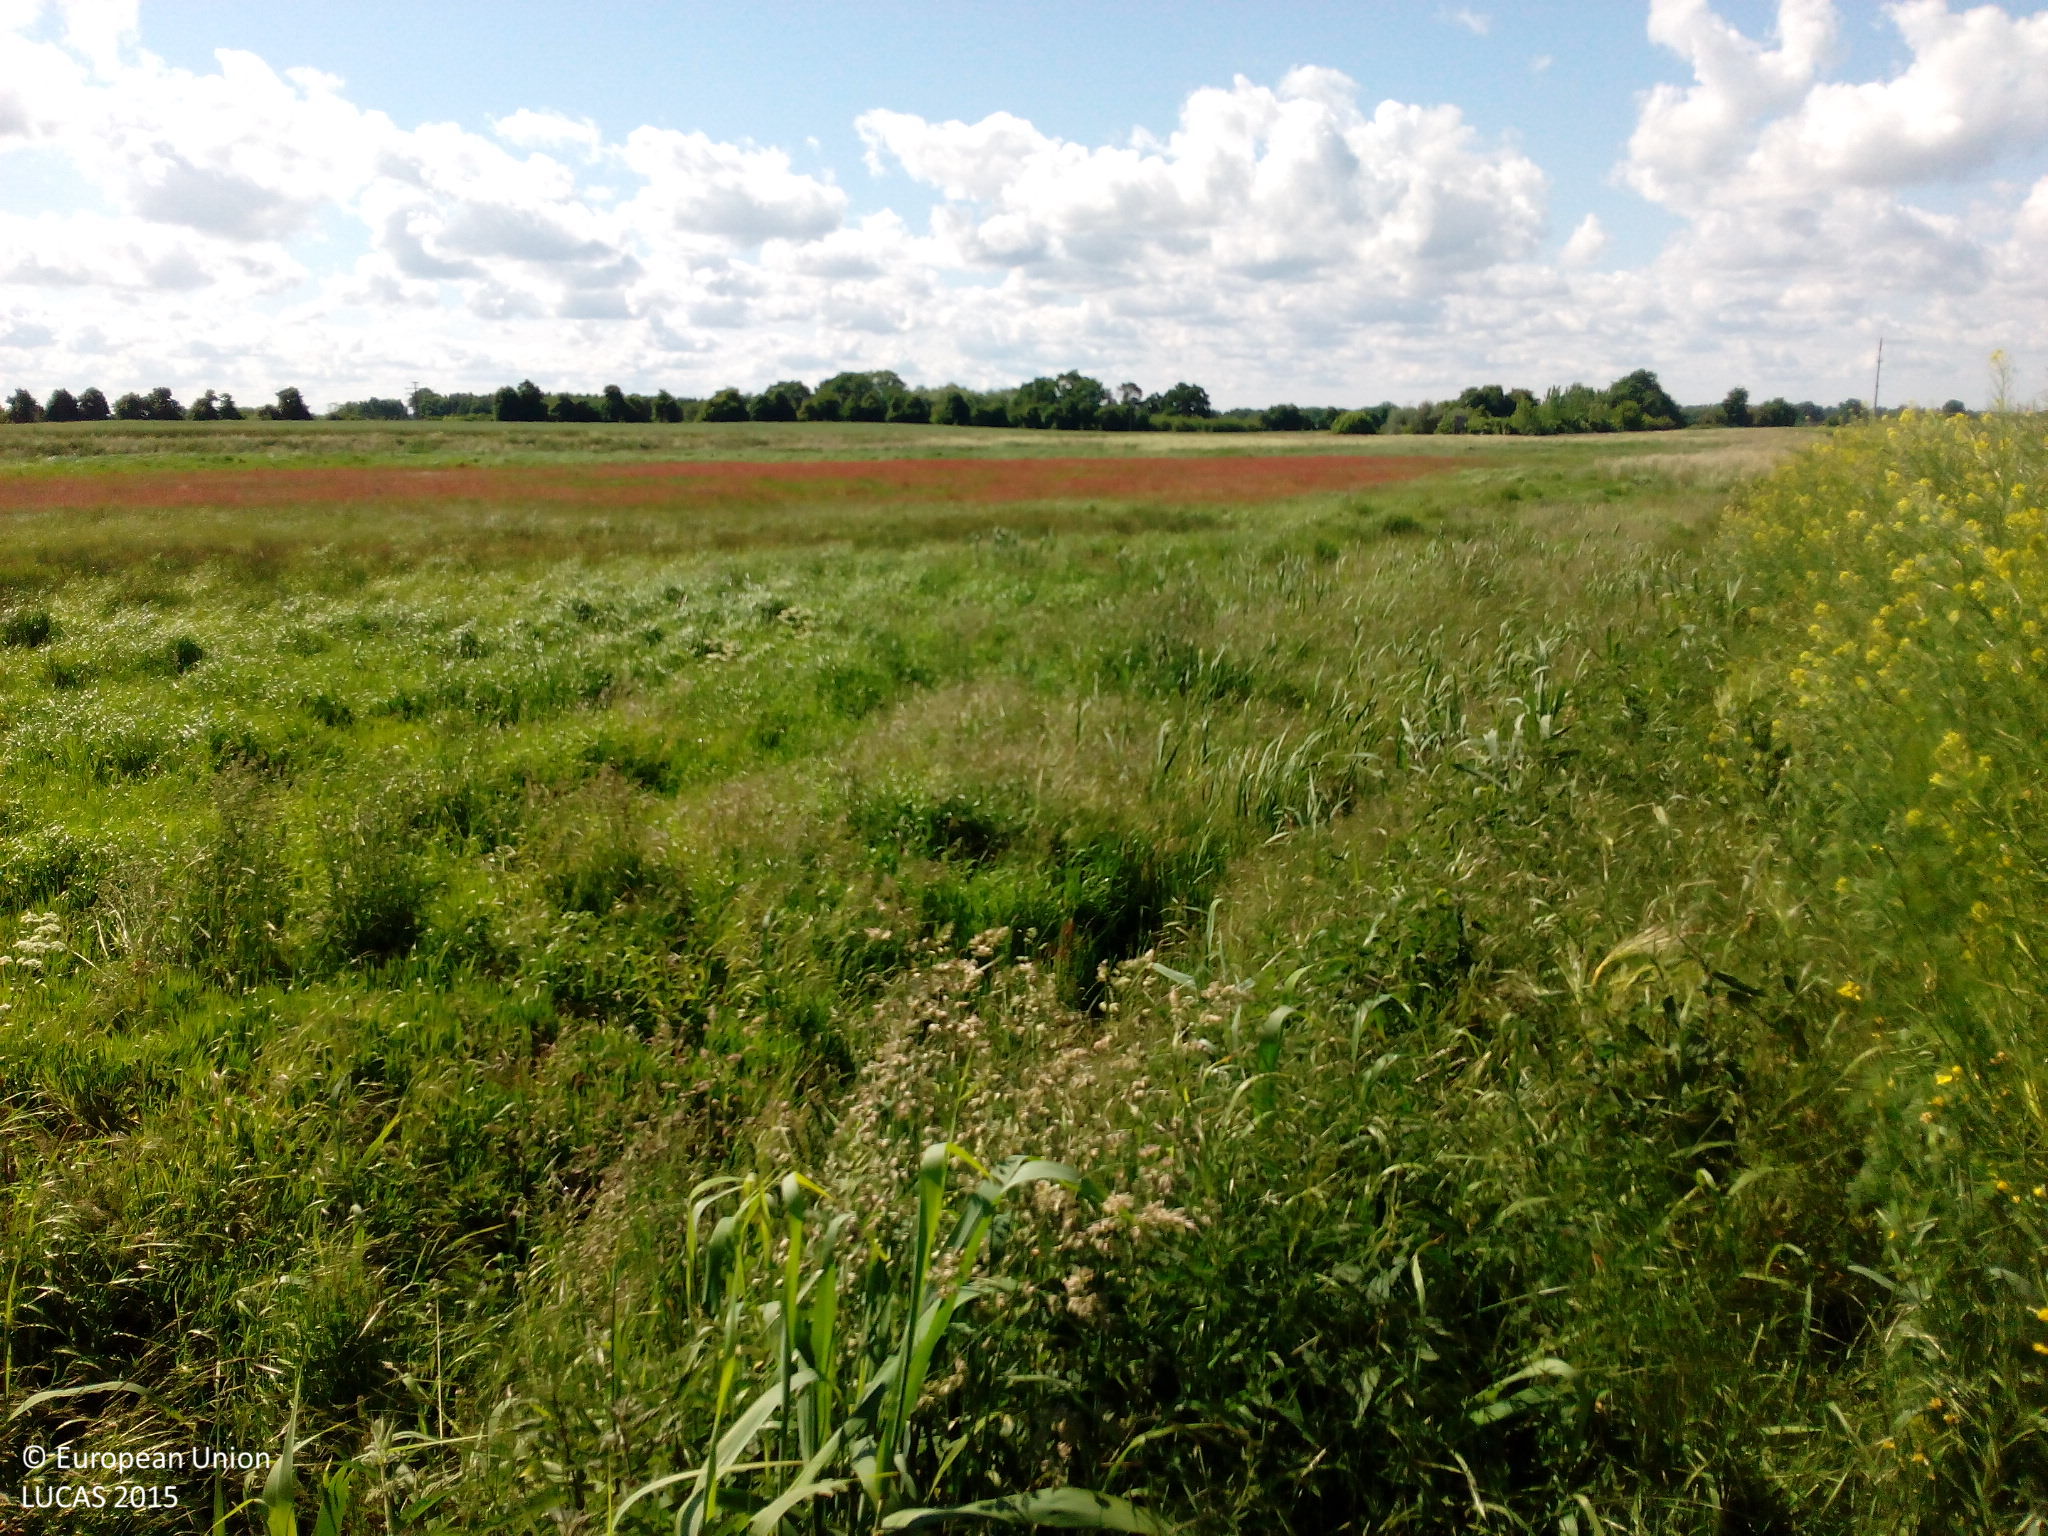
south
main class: Cropland
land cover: Rape and turnip rape
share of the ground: > 75 %
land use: Agriculture (excluding fallow land and kitchen gardens)
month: June
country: DE
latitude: 53.3189
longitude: 12.6564
